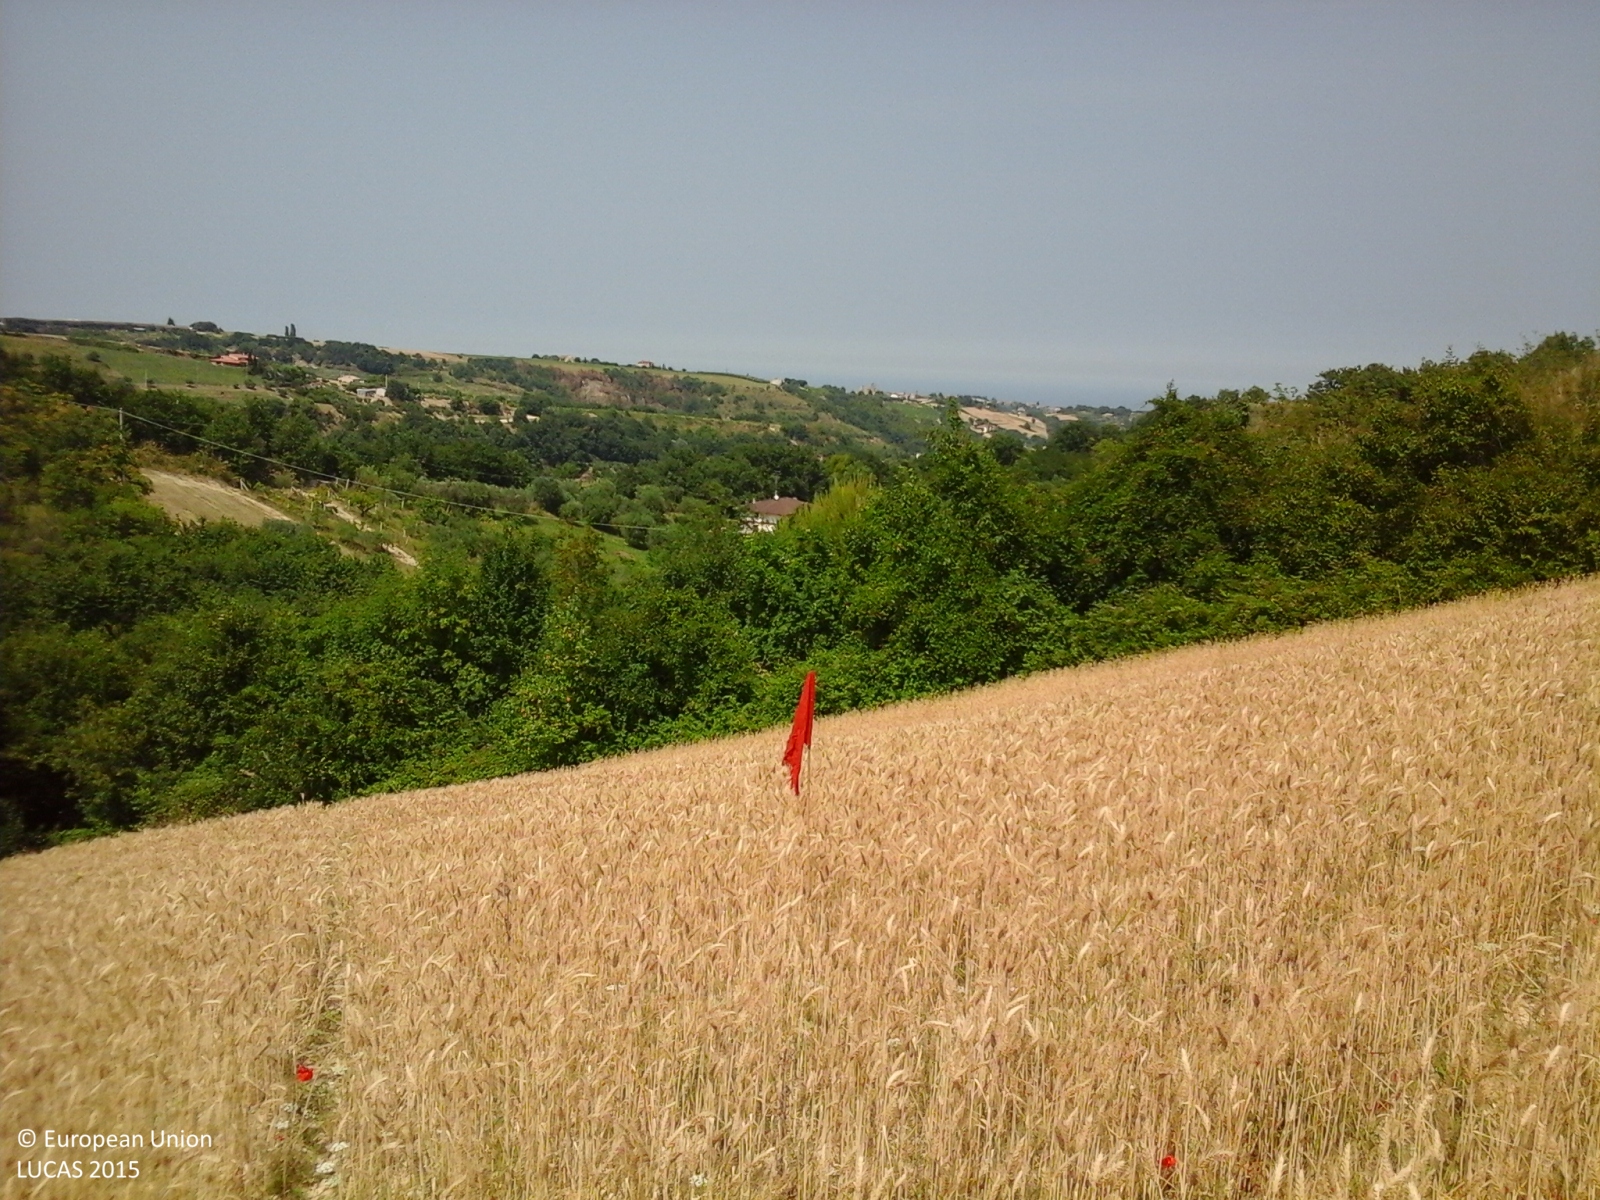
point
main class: Cropland
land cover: Common wheat
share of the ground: > 75 %
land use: Agriculture (excluding fallow land and kitchen gardens)
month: July
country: IT
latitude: 43.0533
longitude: 13.7837
